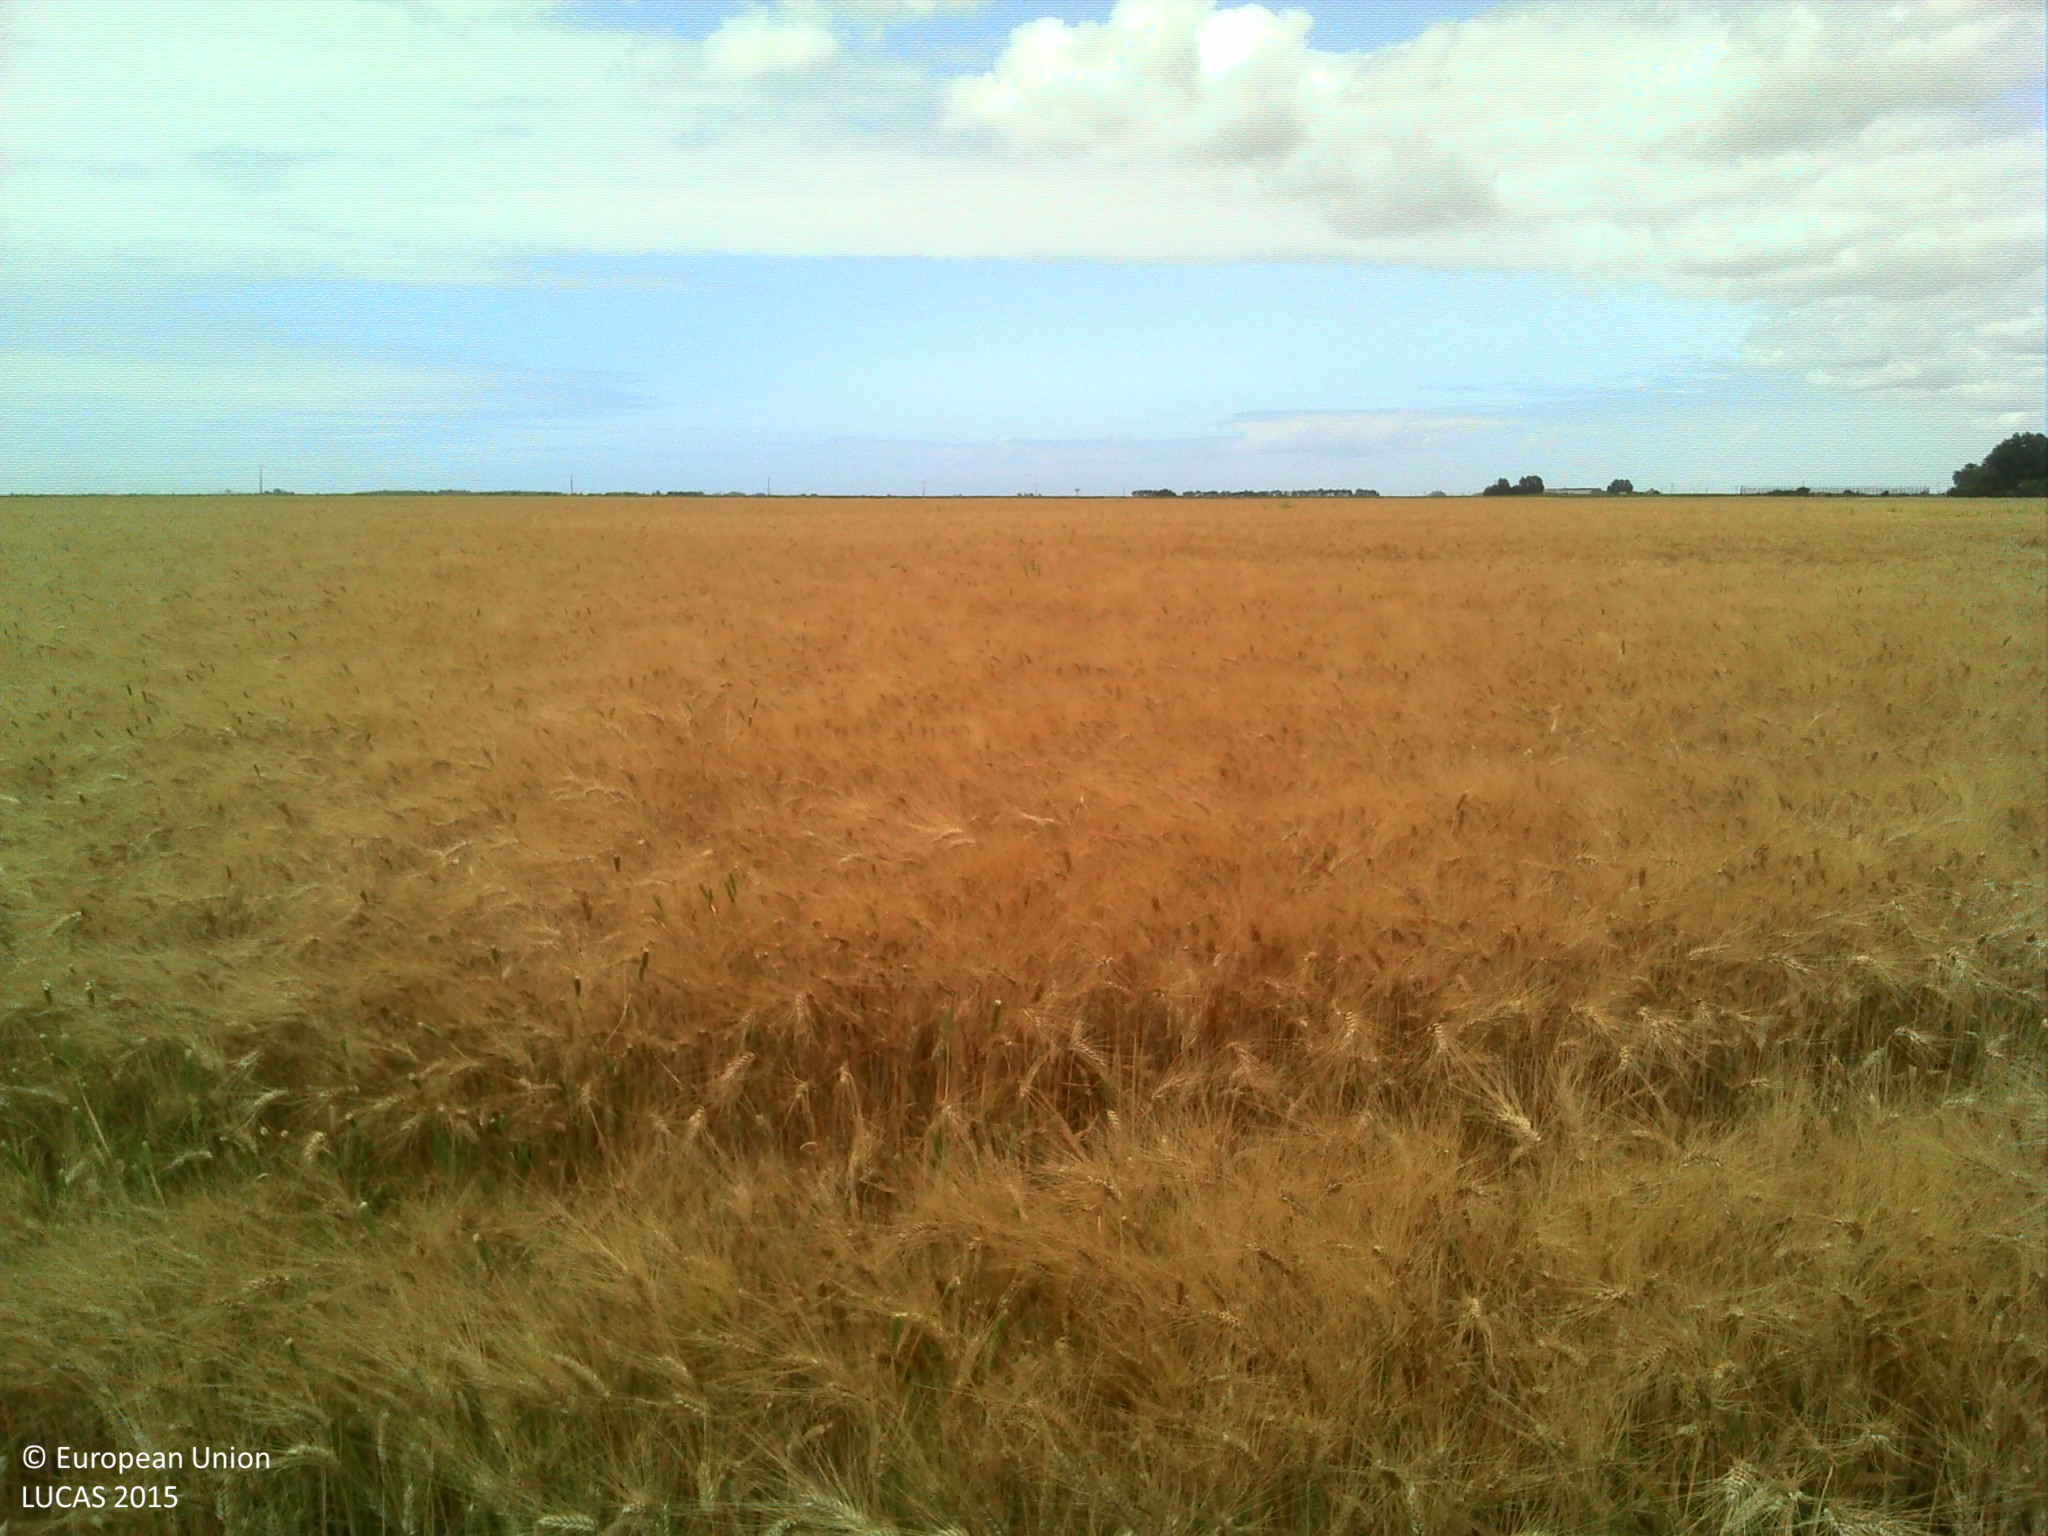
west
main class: Cropland
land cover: Common wheat
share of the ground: > 75 %
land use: Agriculture (excluding fallow land and kitchen gardens)
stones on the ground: < 10 %
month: July
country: FR
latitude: 46.3706
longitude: -1.2790
